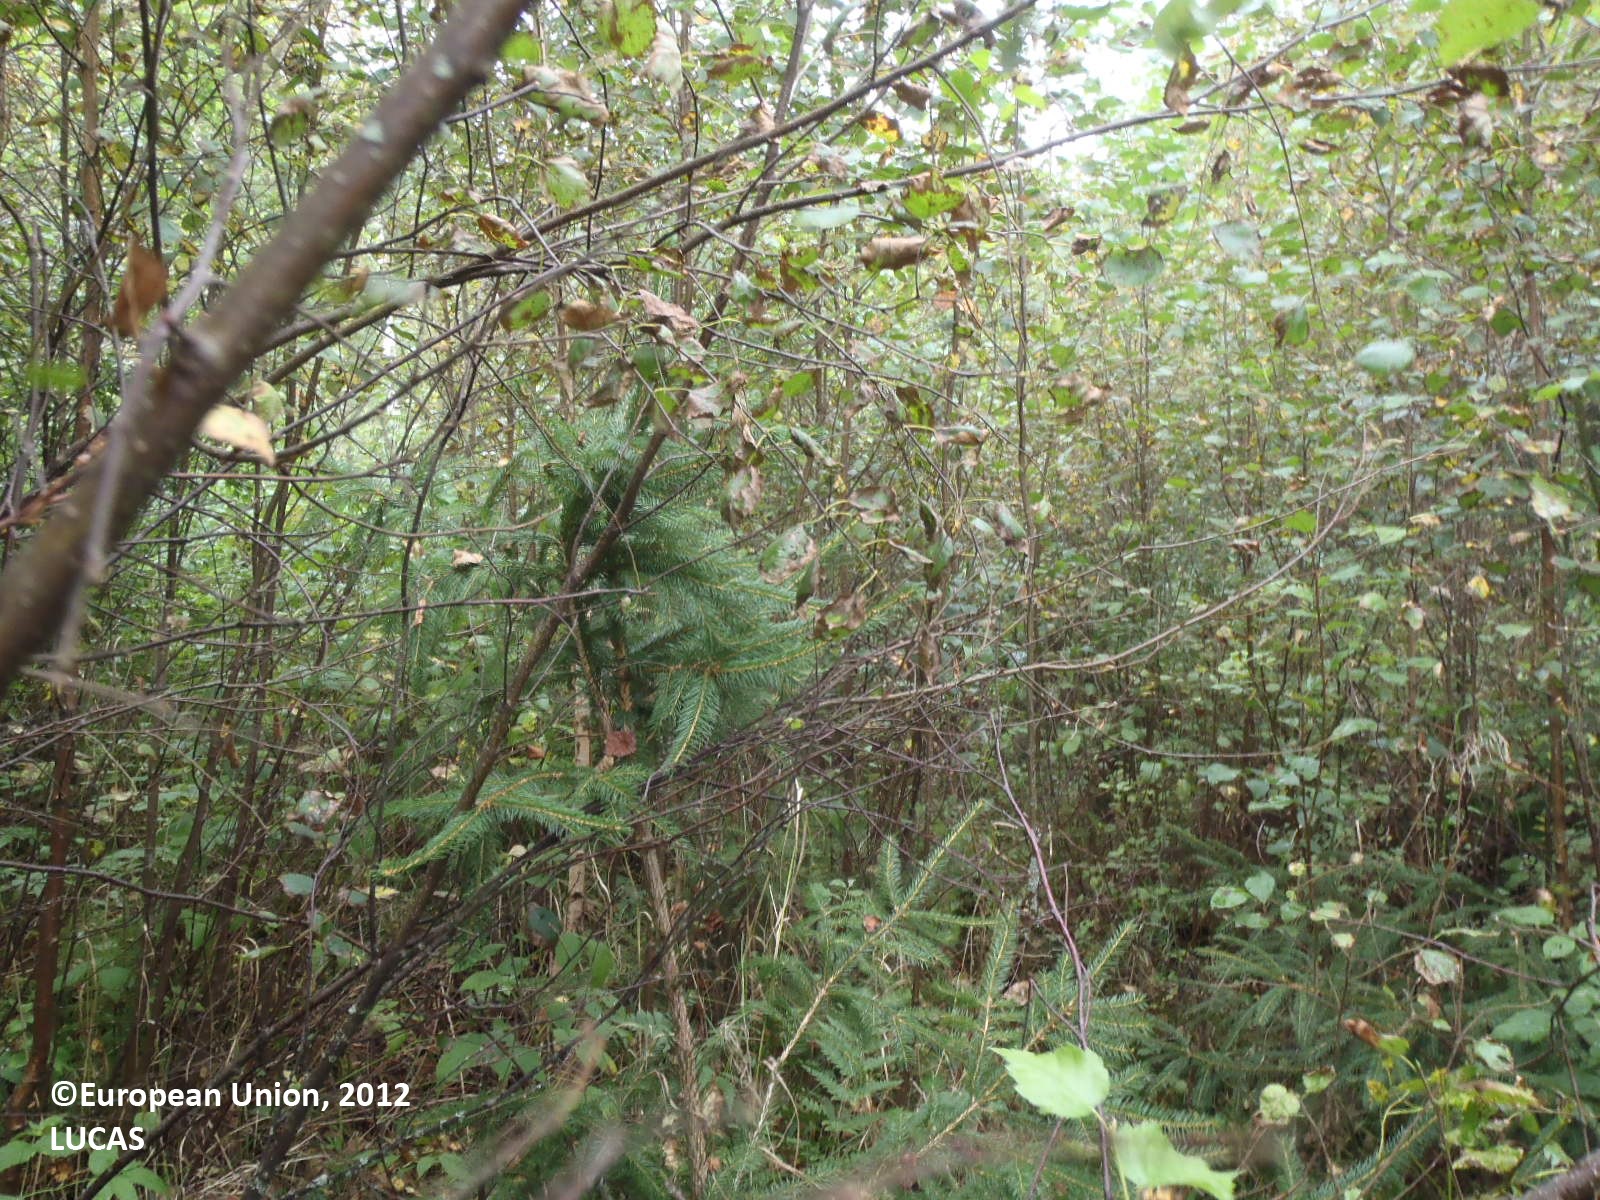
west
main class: Woodland
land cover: Broadleaved woodland
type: boreal forest
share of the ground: > 75 %
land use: Forestry
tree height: > 5 m
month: August
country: FI
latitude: 60.5971
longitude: 22.2083
